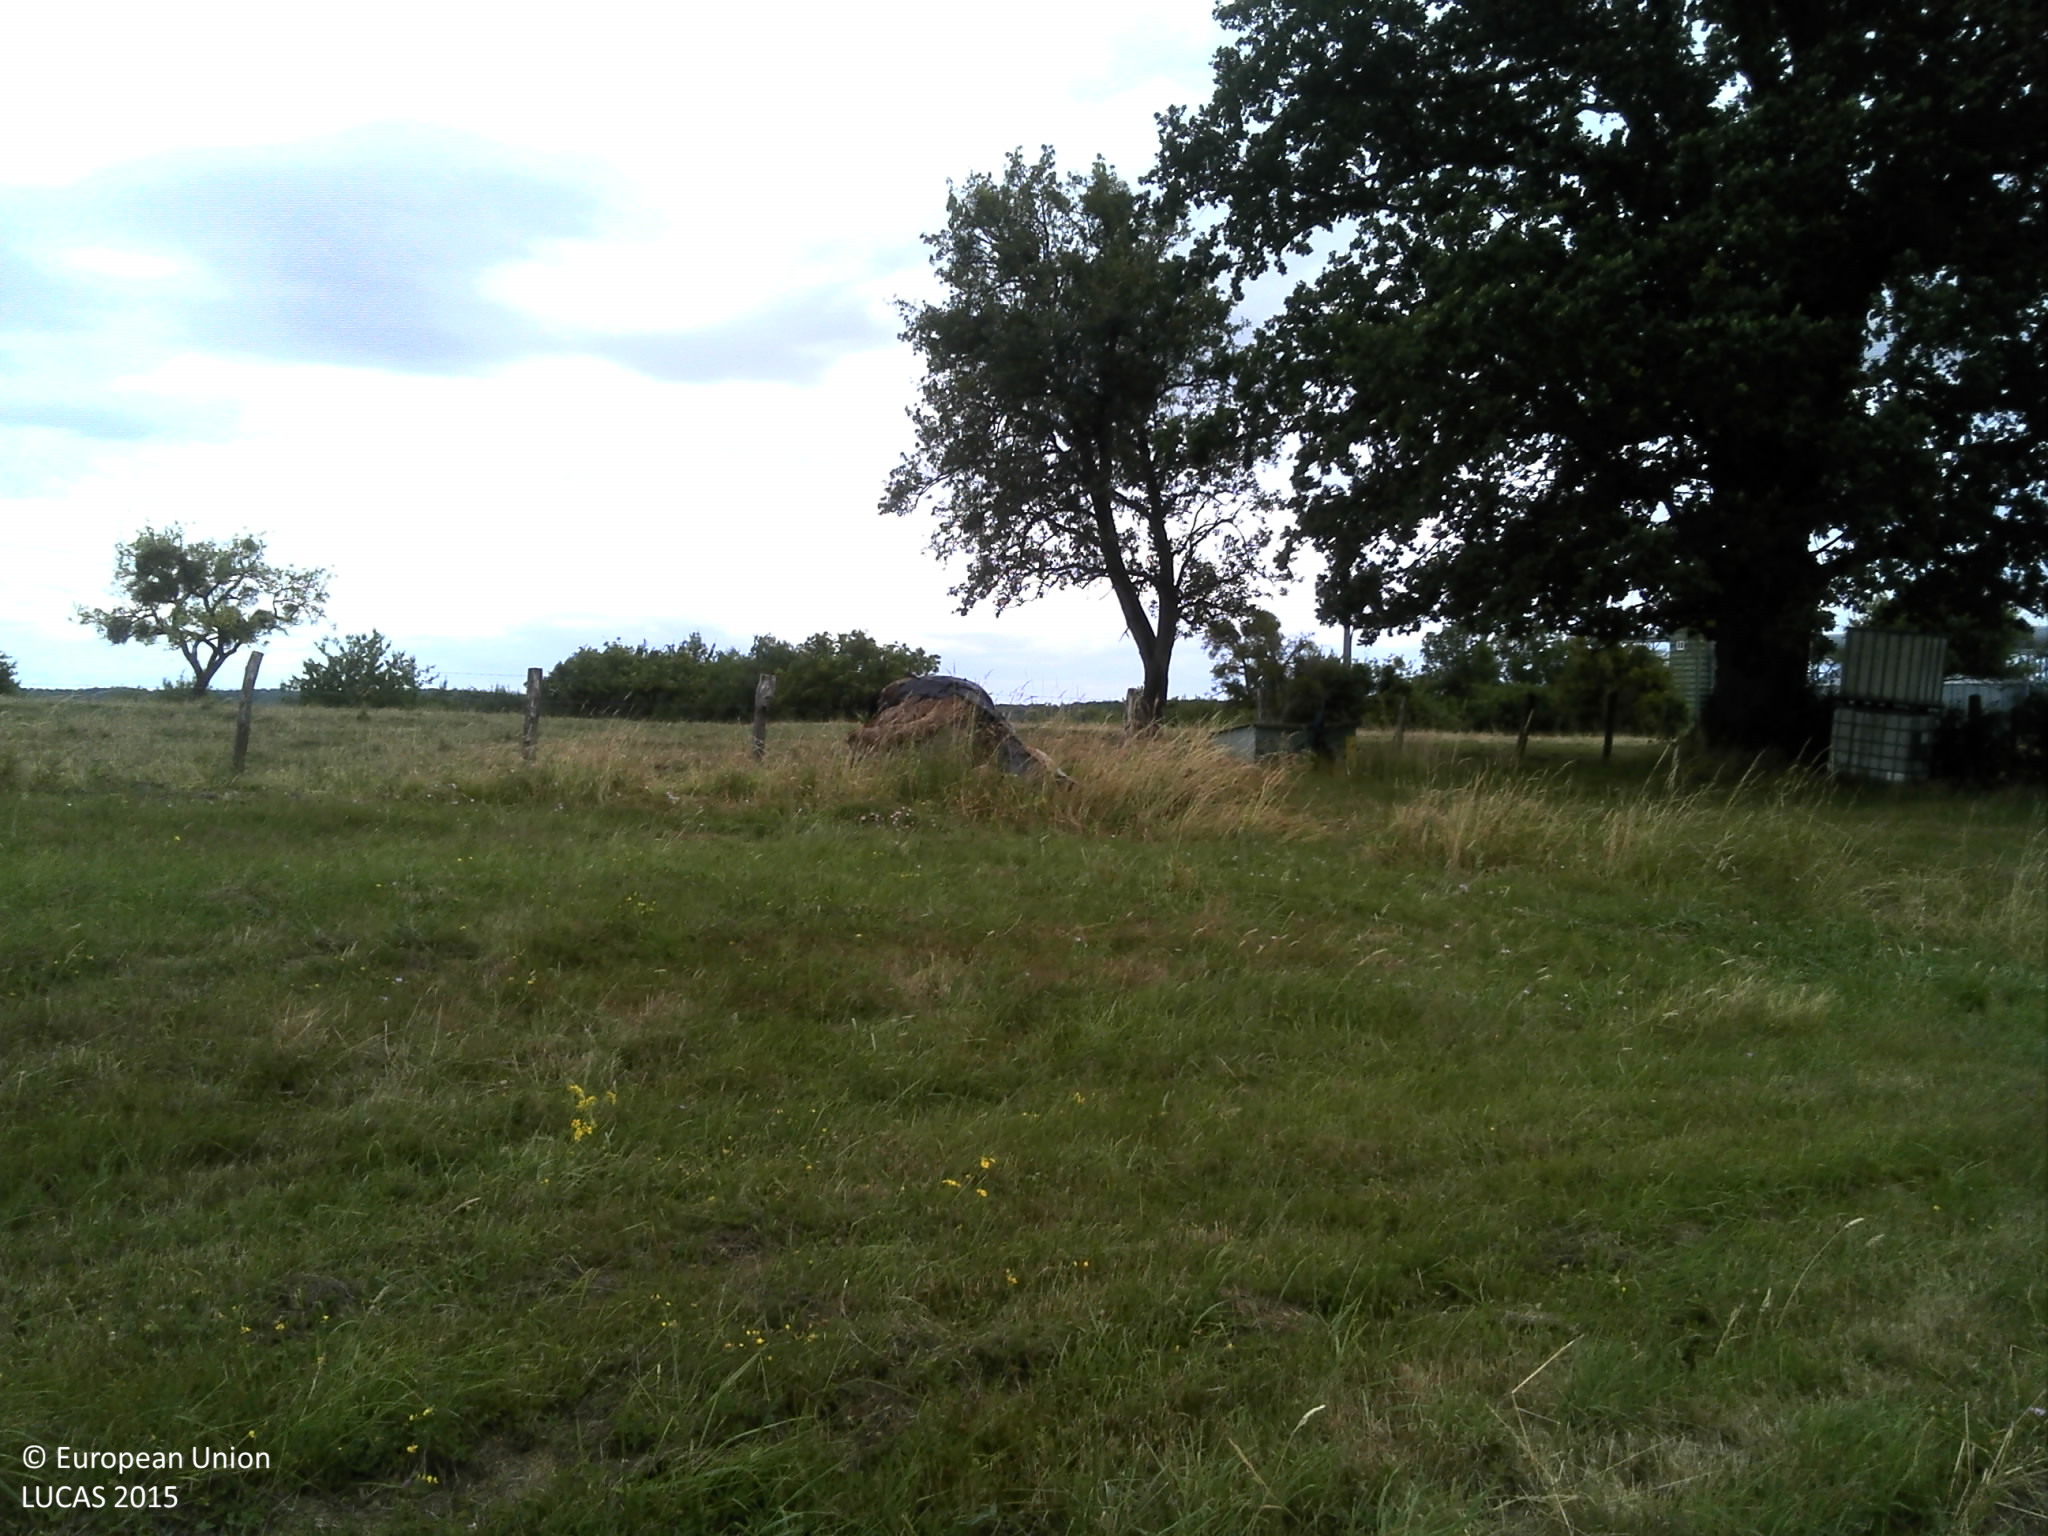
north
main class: Grassland
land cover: Grassland without tree/shrub cover
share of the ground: > 75 %
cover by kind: herbaceous plants 100 %
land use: Residential
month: July
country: FR
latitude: 49.3553
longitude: 6.4617
